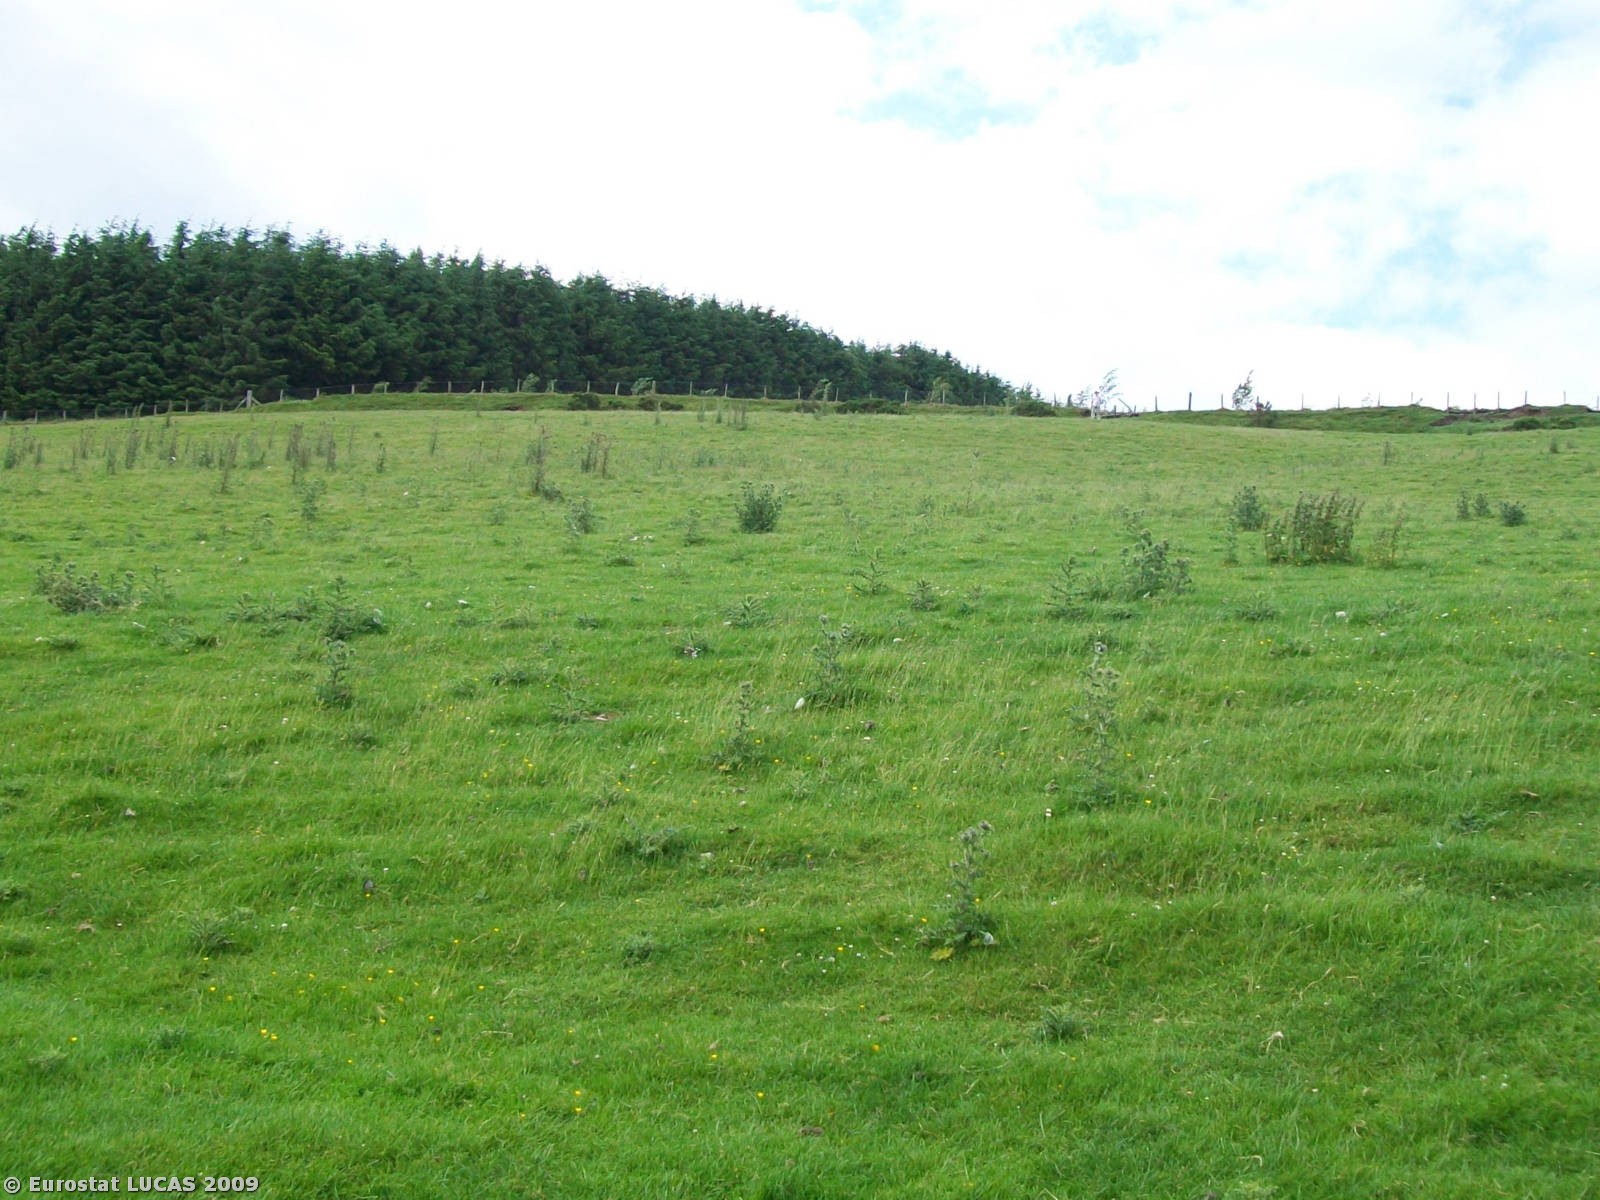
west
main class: Grassland
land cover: Grassland without tree/shrub cover
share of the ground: > 75 %
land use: Agriculture (excluding fallow land and kitchen gardens)
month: June
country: GB
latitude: 53.1315
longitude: -3.5209
